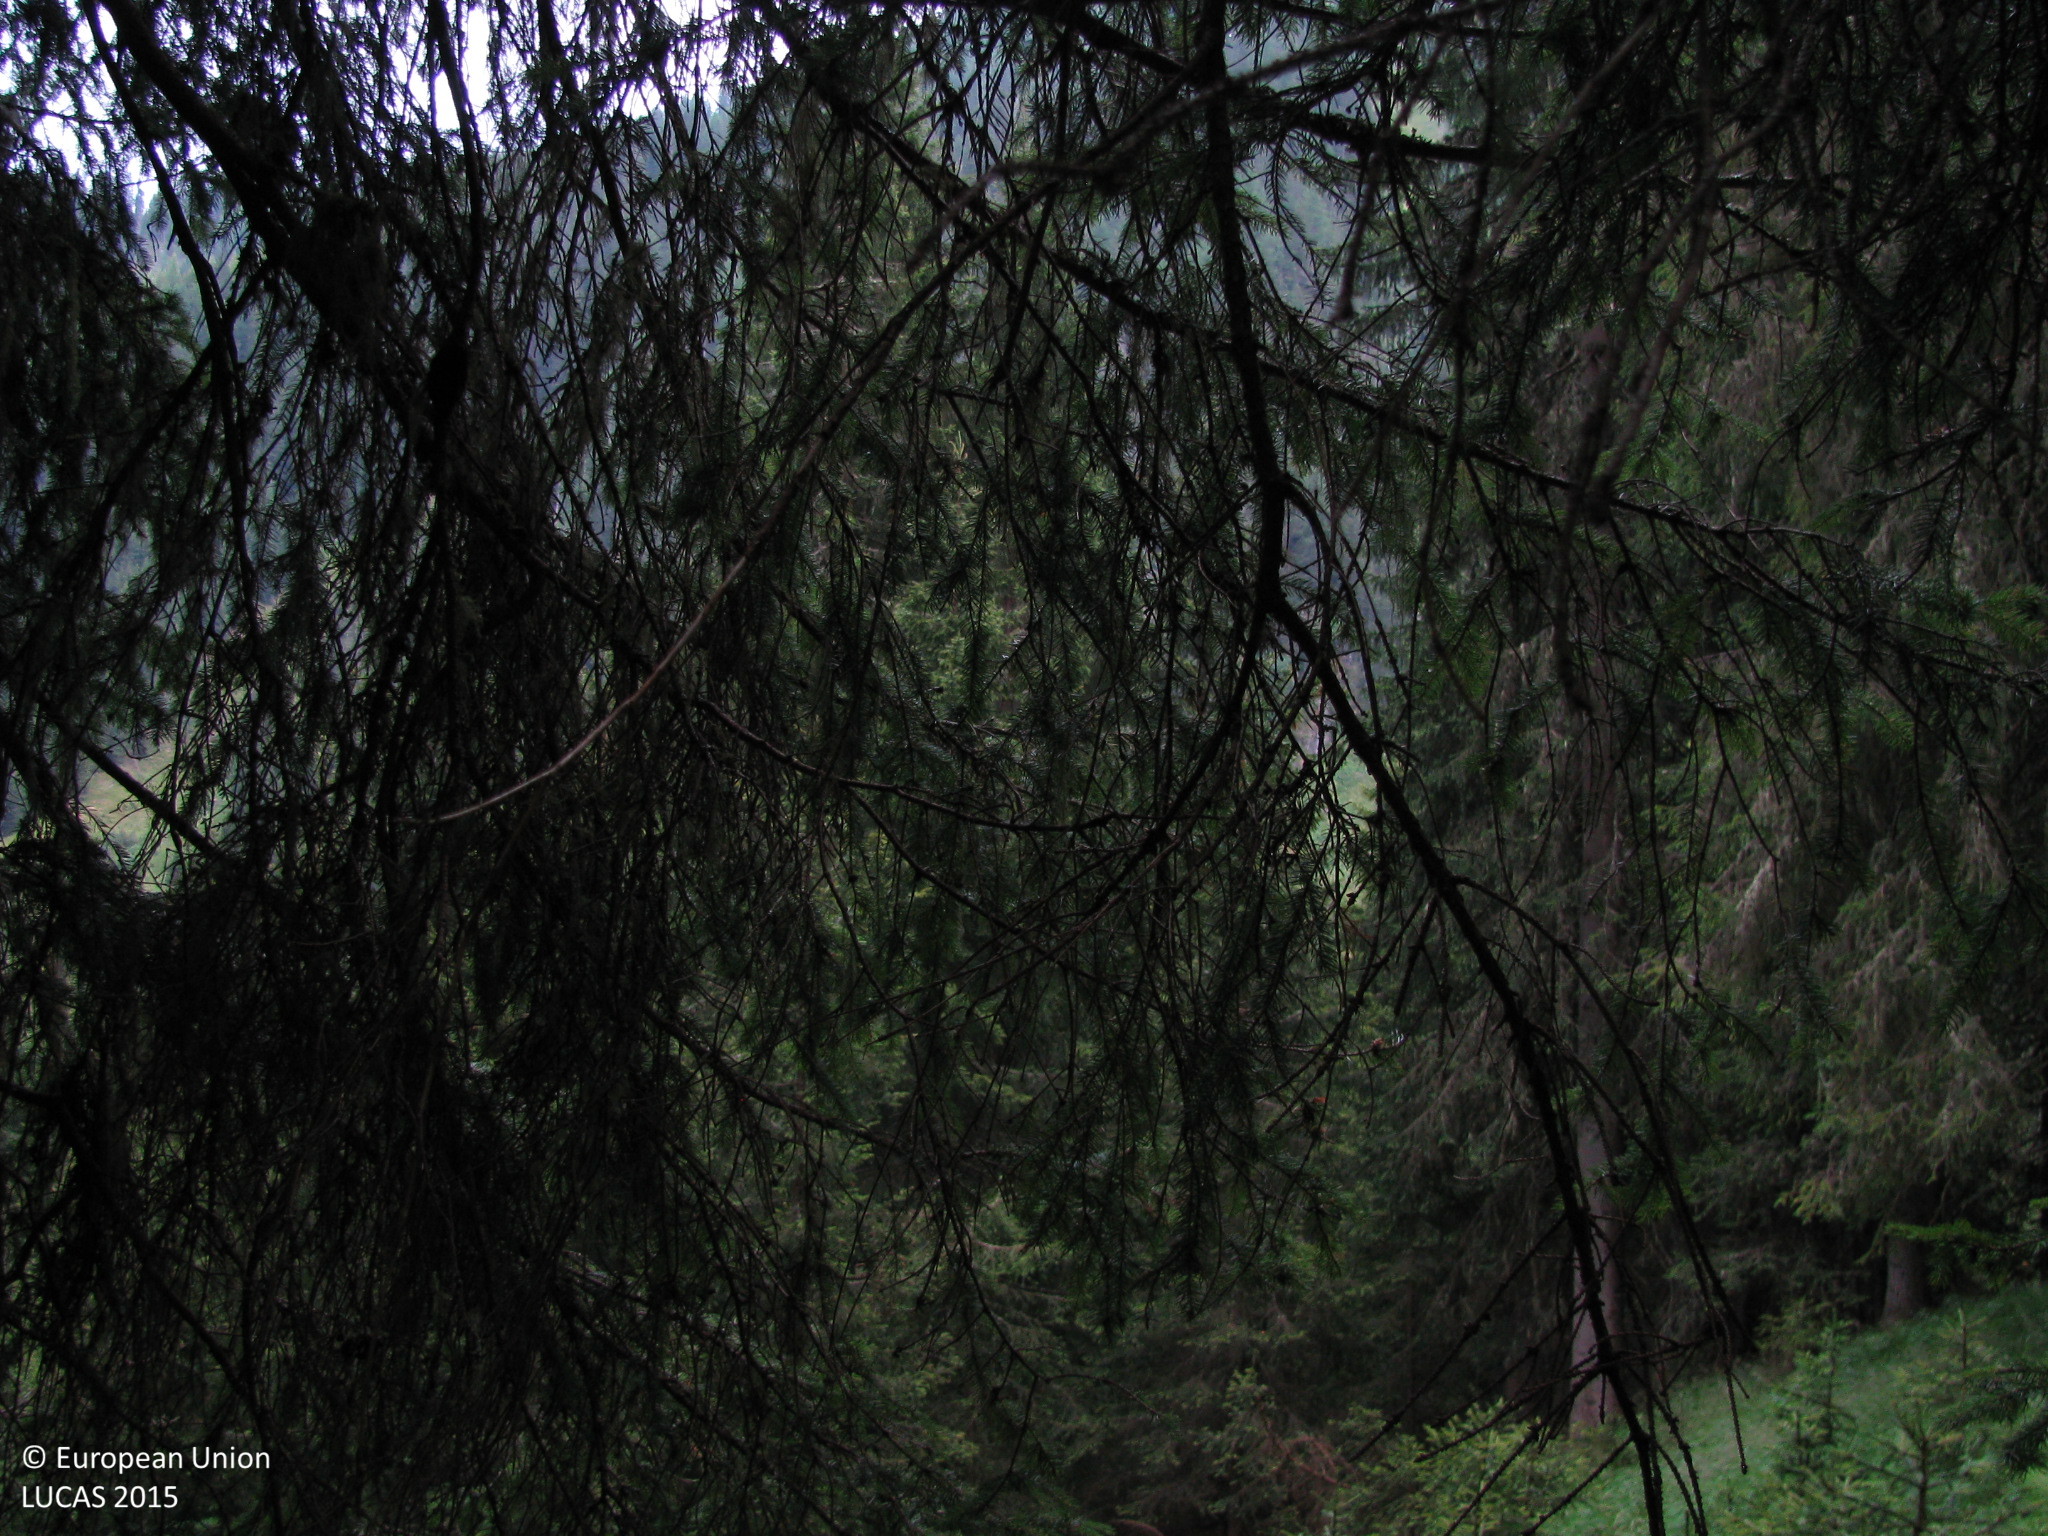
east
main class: Woodland
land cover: Spruce dominated coniferous woodland
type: alpine coniferous forest
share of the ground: > 75 %
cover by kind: coniferous forest trees 75 %, herbaceous plants 15 %, lichens and mosses 5 %, unconsolidated bare surface 5 %
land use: Forestry
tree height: > 5 m
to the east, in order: Spruce dominated coniferous woodland; Tracks; Spruce dominated coniferous woodland; Inland fresh running water; Spruce dominated coniferous woodland; Tracks; Spruce dominated coniferous woodland; Tracks; Spruce dominated coniferous woodland
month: July
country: AT
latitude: 46.6788
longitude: 12.6513
